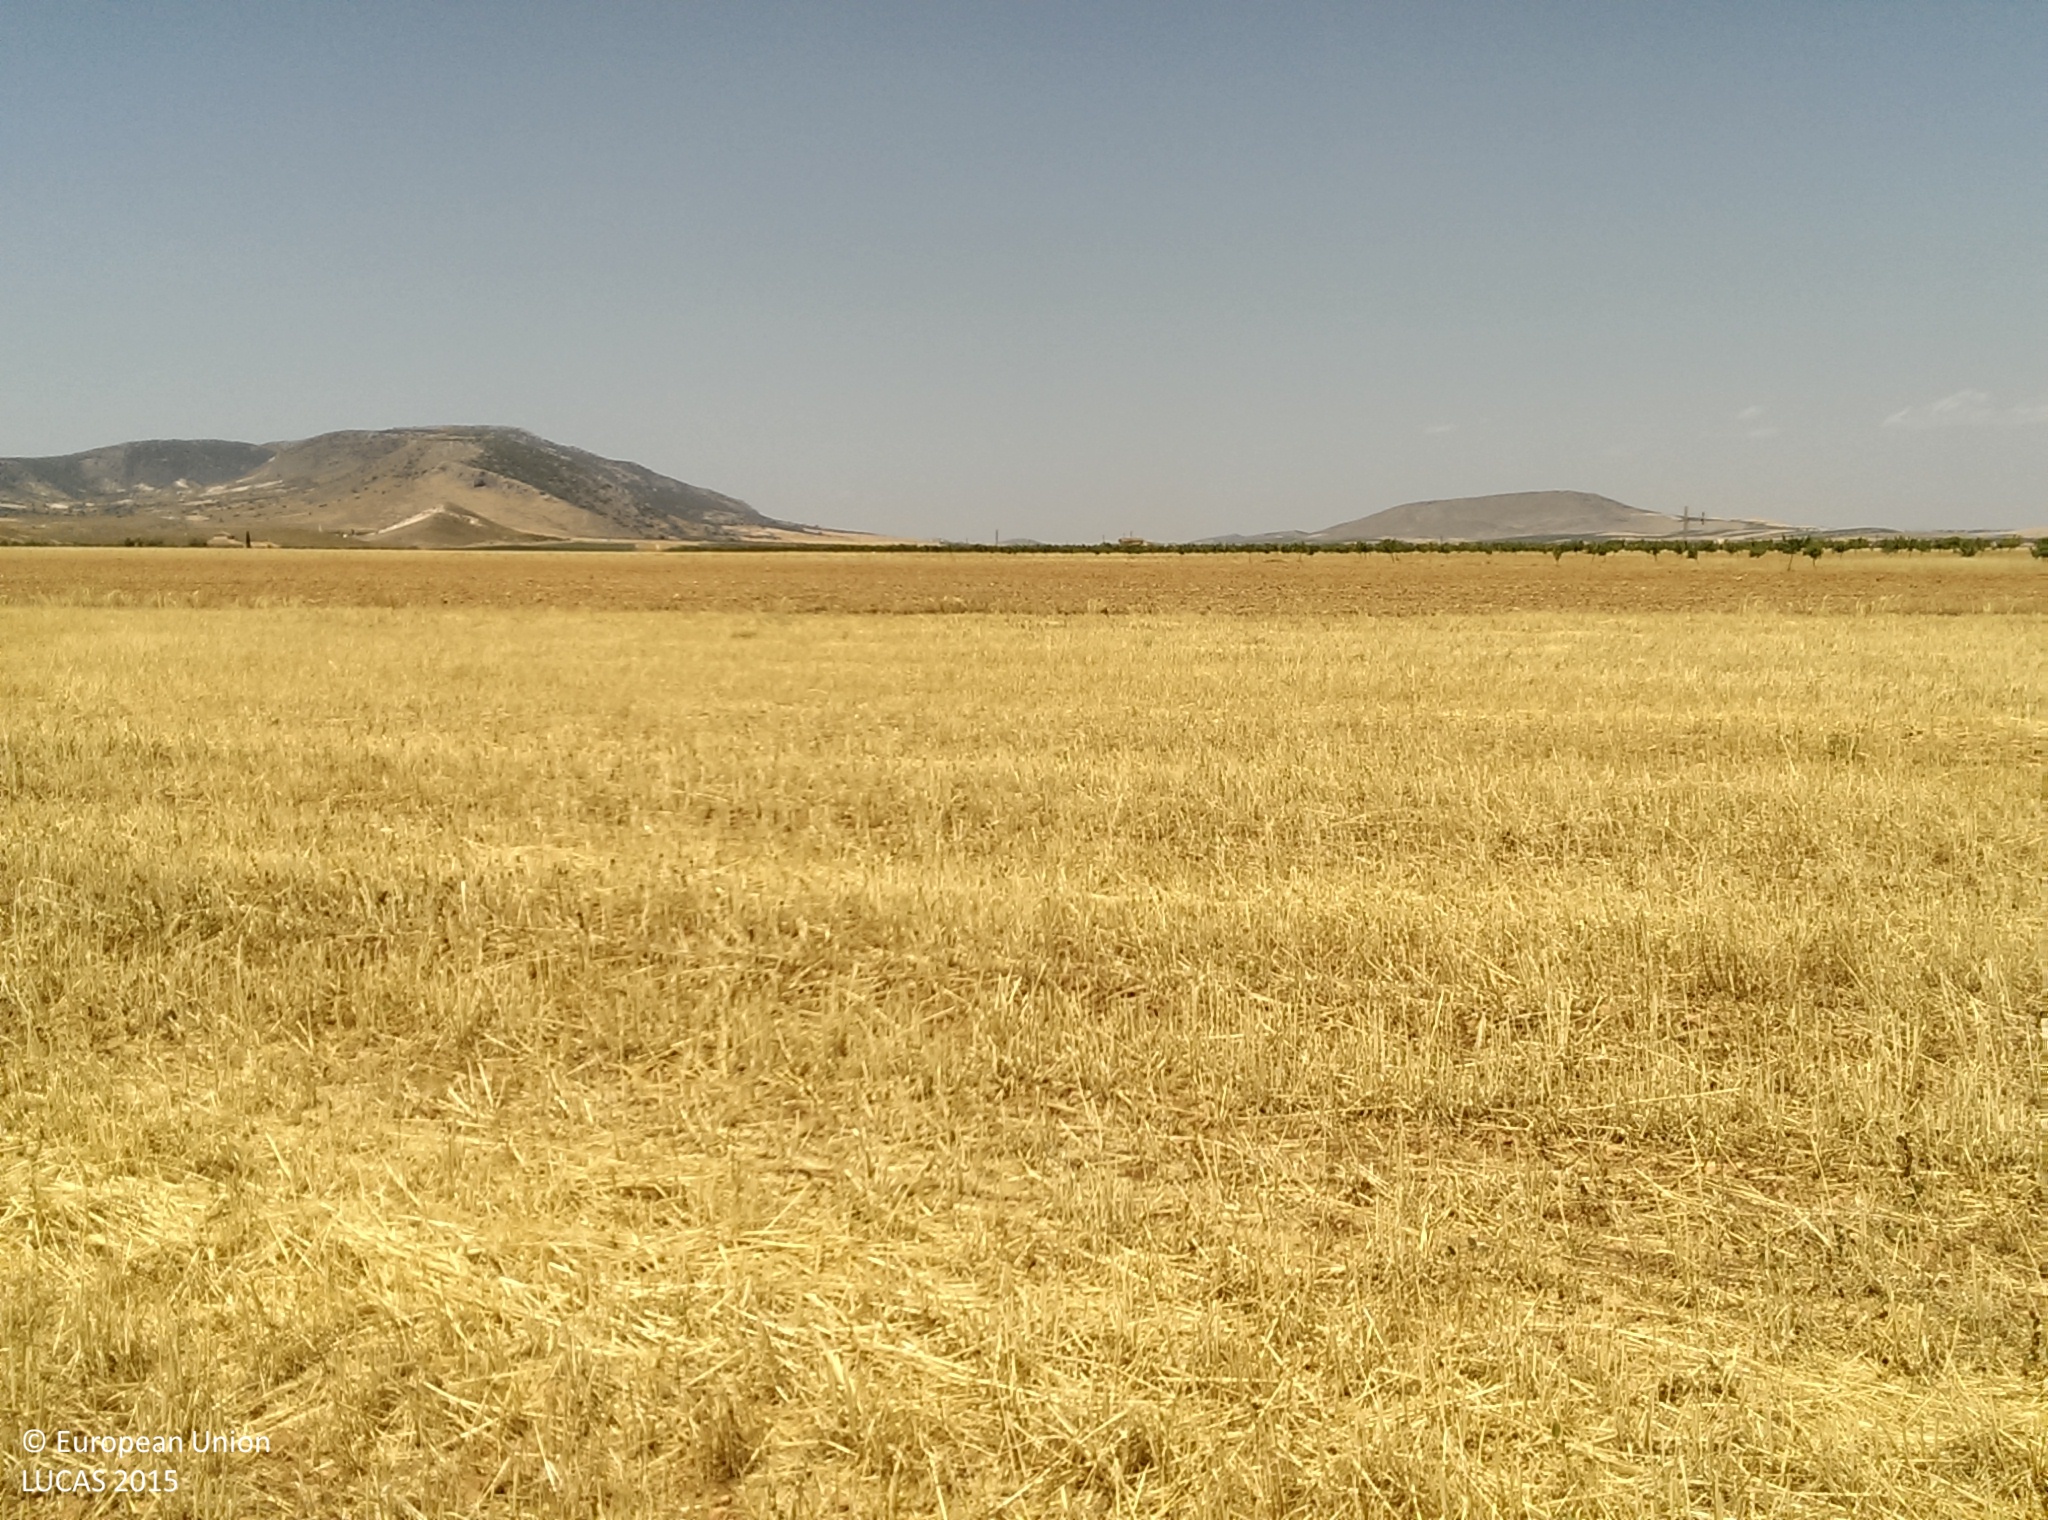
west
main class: Cropland
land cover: Barley
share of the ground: < 10 %
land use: Agriculture (excluding fallow land and kitchen gardens)
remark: Harvested field
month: July
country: ES
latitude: 37.4044
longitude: -3.2411
